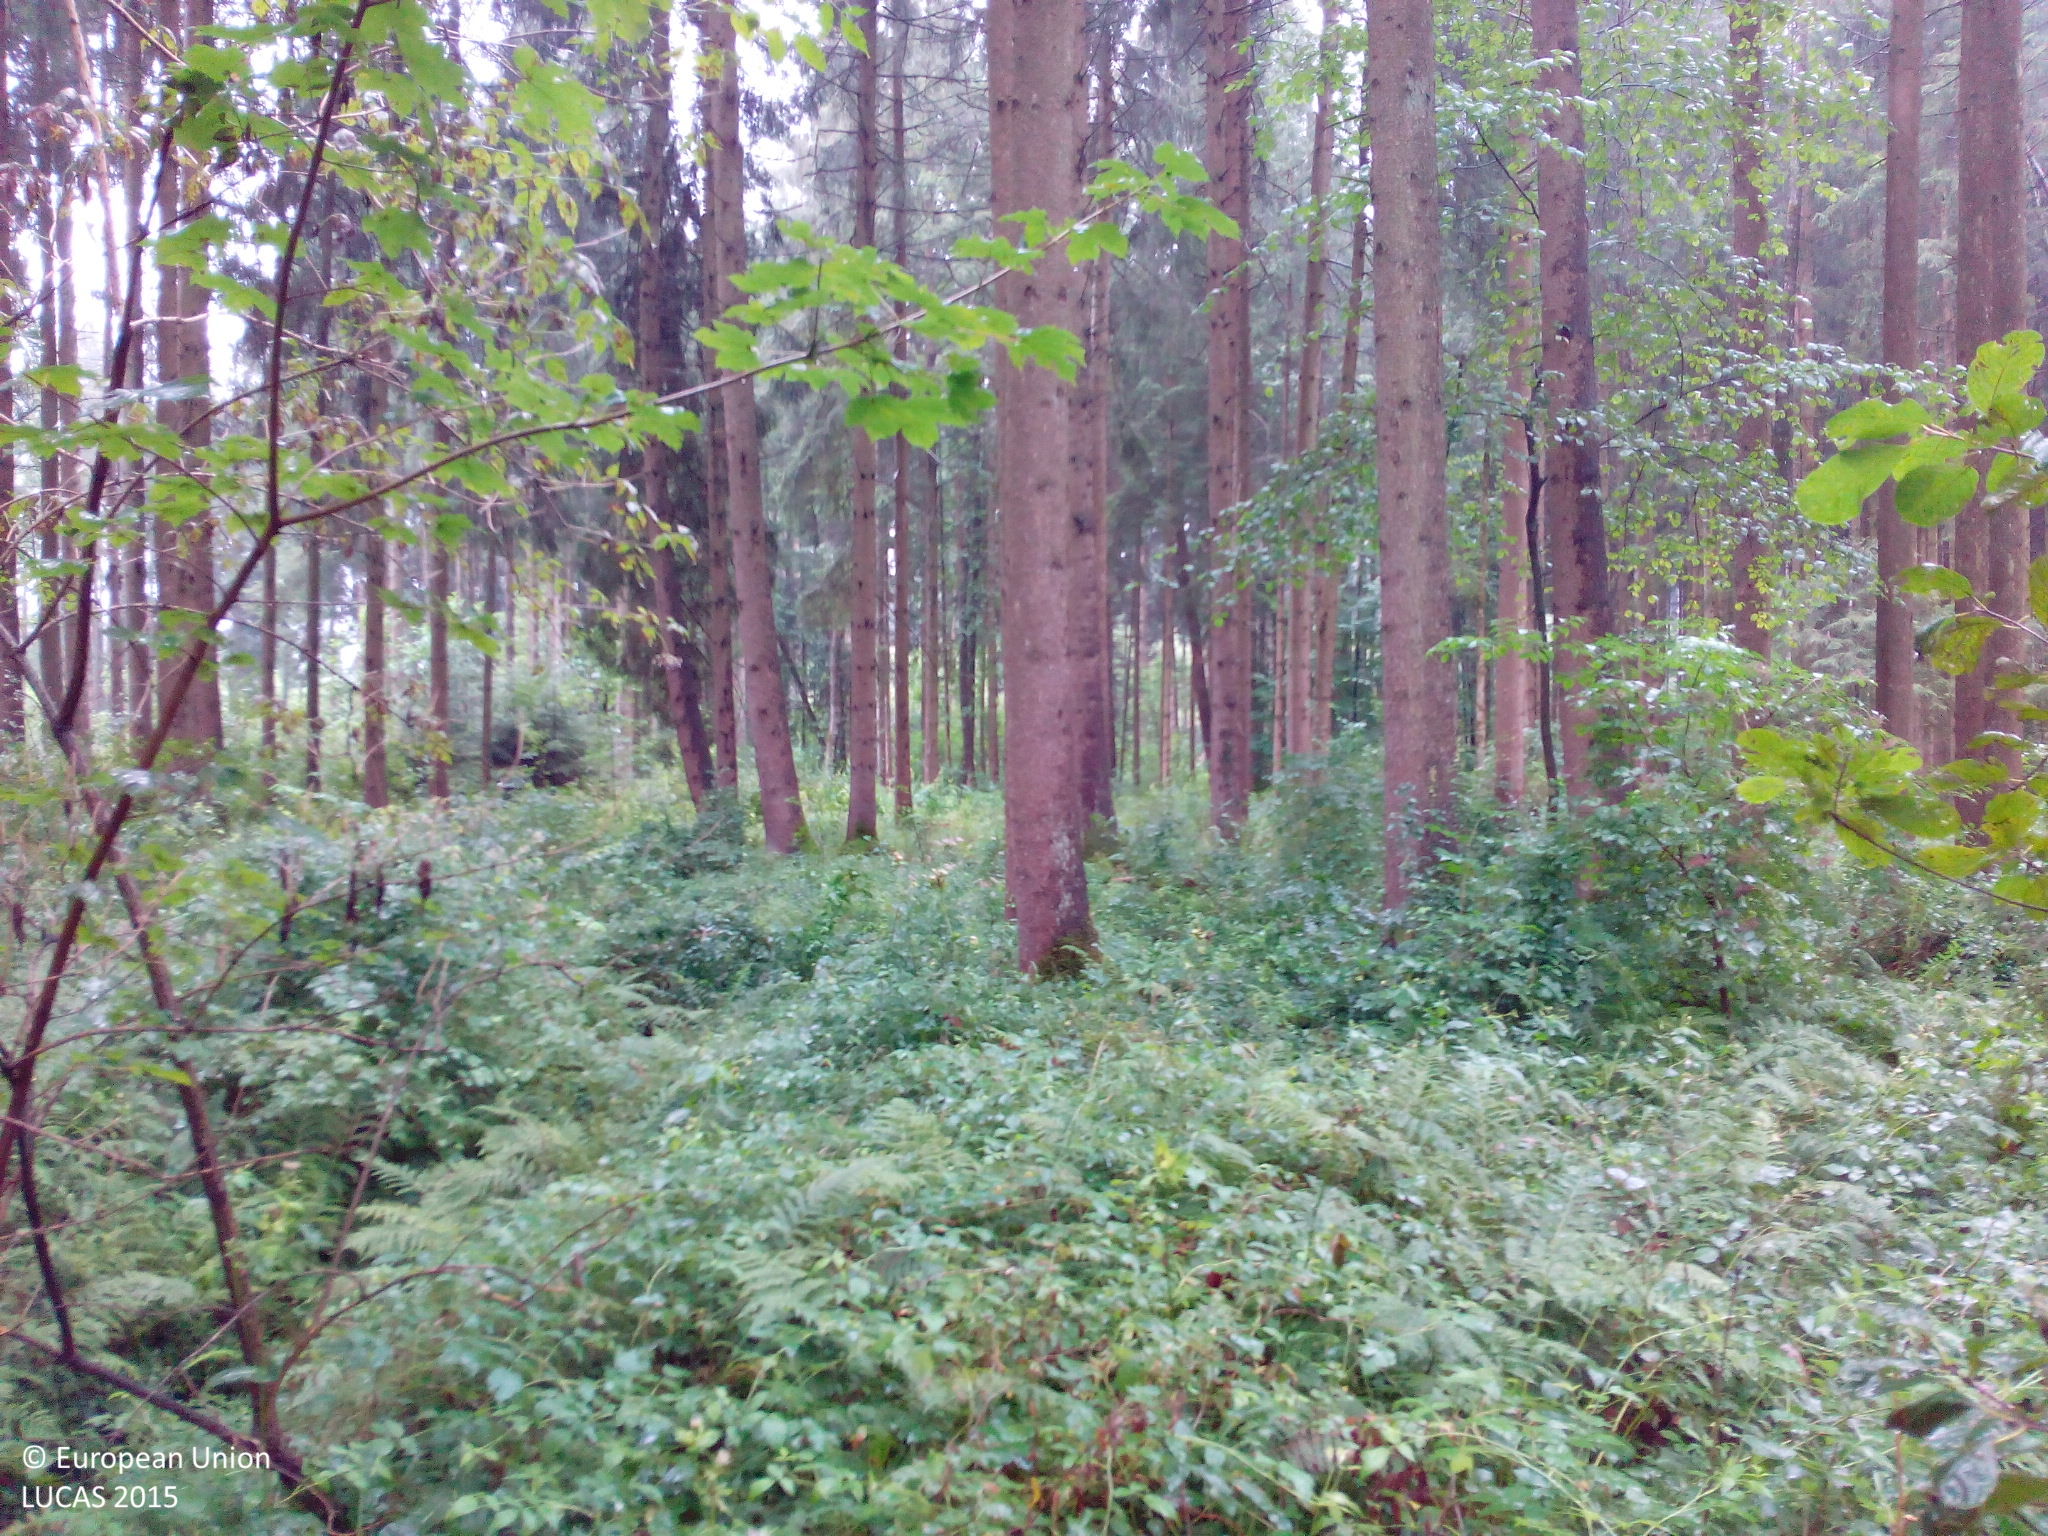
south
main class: Woodland
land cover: Spruce dominated coniferous woodland
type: hemiboreal forest and nemoral coniferous forest and mixed broadleaved-coniferous forest
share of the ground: > 75 %
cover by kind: coniferous forest trees 75 %, shrubs 20 %, broadleaved forest trees 5 %
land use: Forestry
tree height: > 5 m
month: August
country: DE
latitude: 47.8980
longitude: 12.8746
